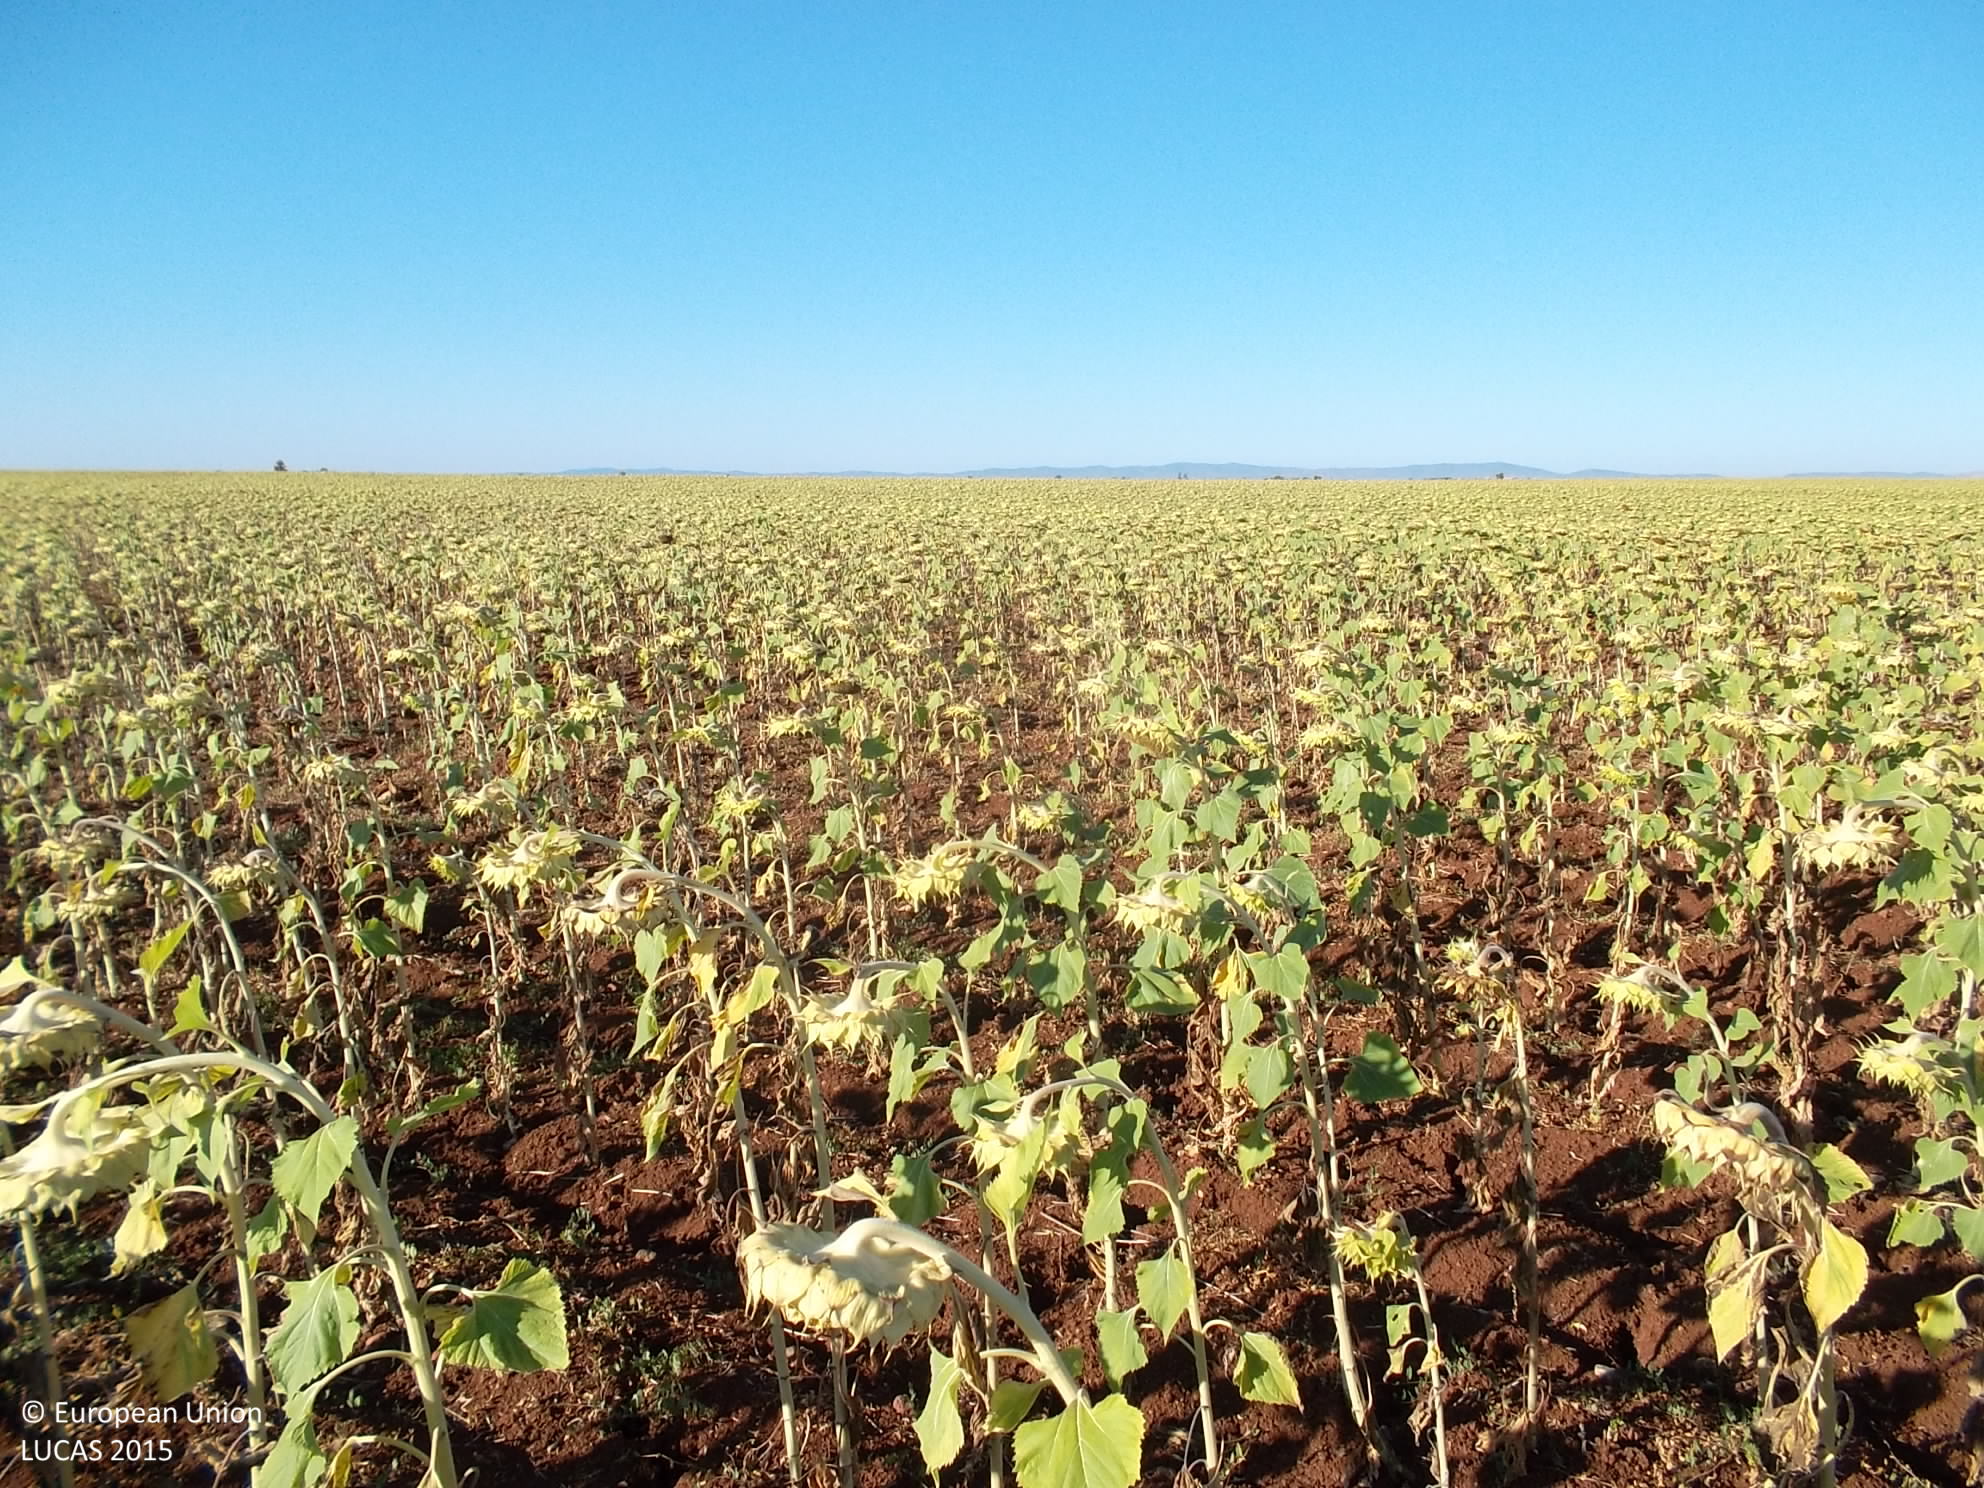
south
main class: Cropland
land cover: Sunflower
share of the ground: > 75 %
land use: Agriculture (excluding fallow land and kitchen gardens)
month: July
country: ES
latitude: 38.3465
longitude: -5.7236
